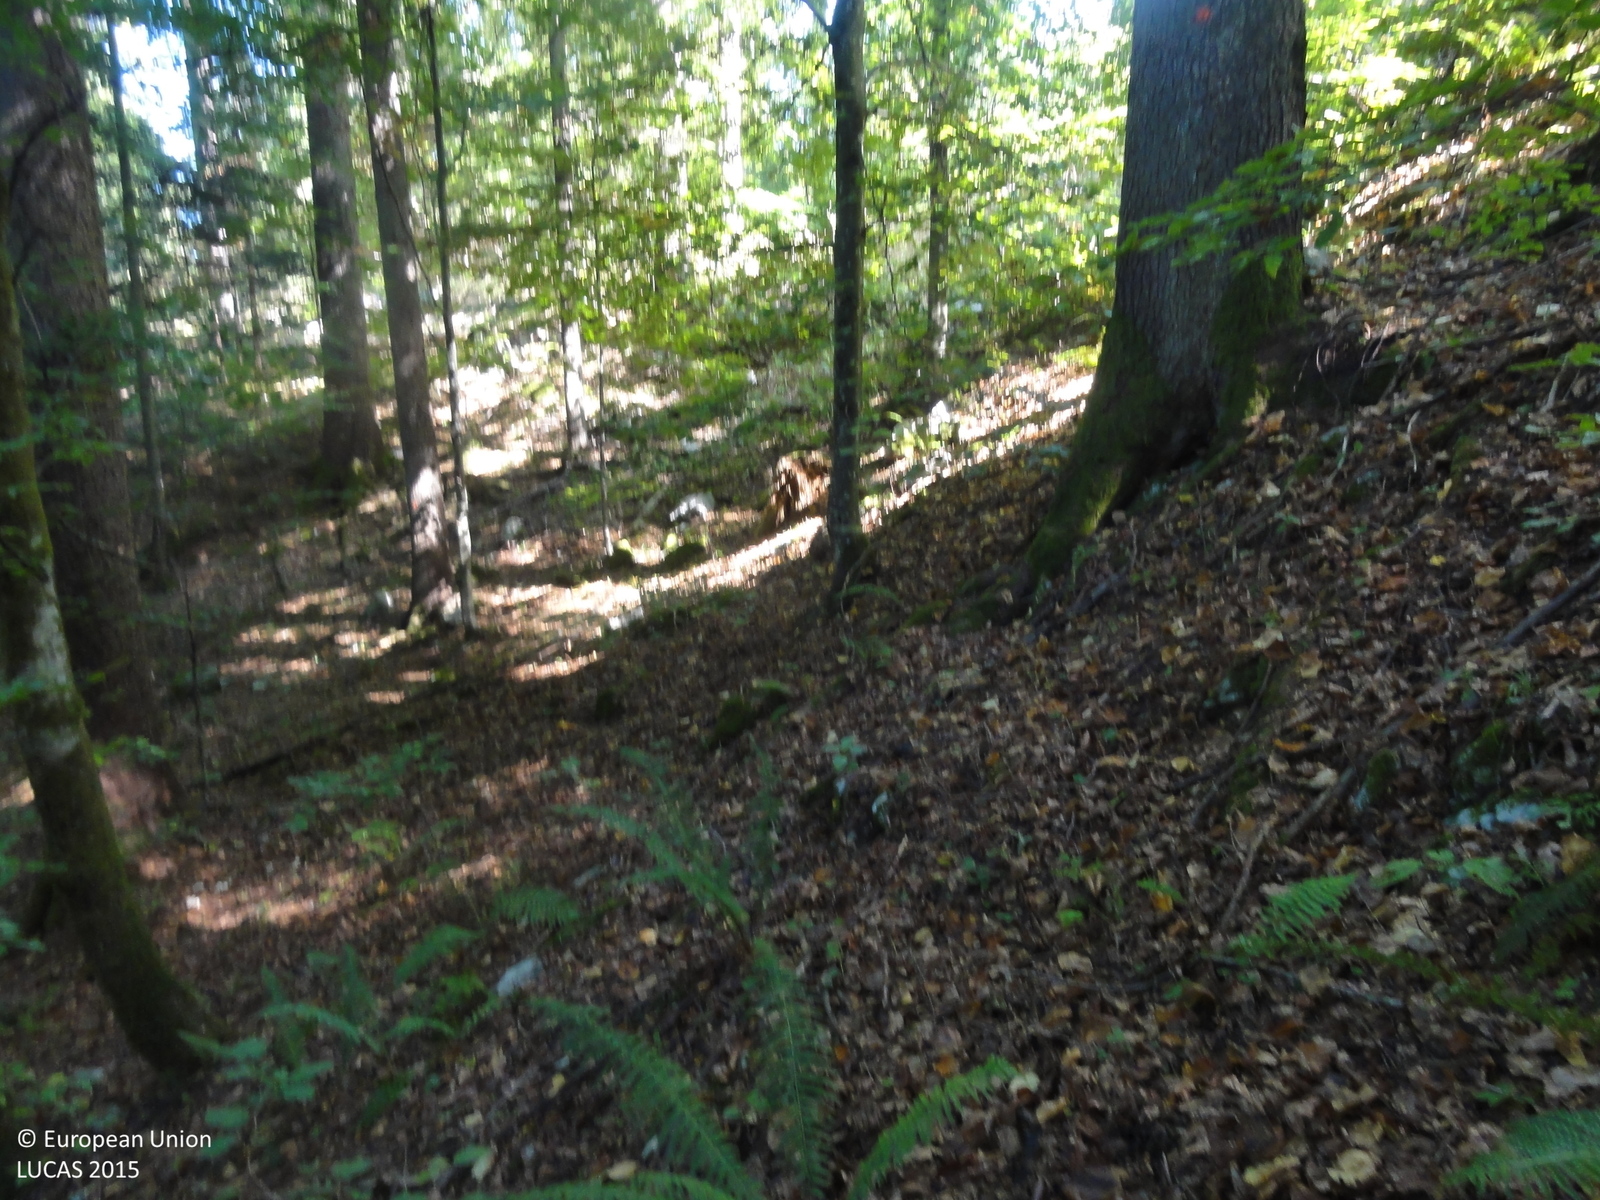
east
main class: Woodland
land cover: Spruce dominated mixed woodland
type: mountainous beech forest
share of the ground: > 75 %
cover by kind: broadleaved forest trees 45 %, coniferous forest trees 40 %, herbaceous plants 5 %, consolidated bare surface 5 %, unconsolidated bare surface 5 %
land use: Forestry
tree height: > 5 m
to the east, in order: Spruce dominated mixed woodland; Tracks; Spruce dominated mixed woodland; Tracks; Spruce dominated mixed woodland; Tracks; Spruce dominated mixed woodland
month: September
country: SI
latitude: 45.6921
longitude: 15.0171
